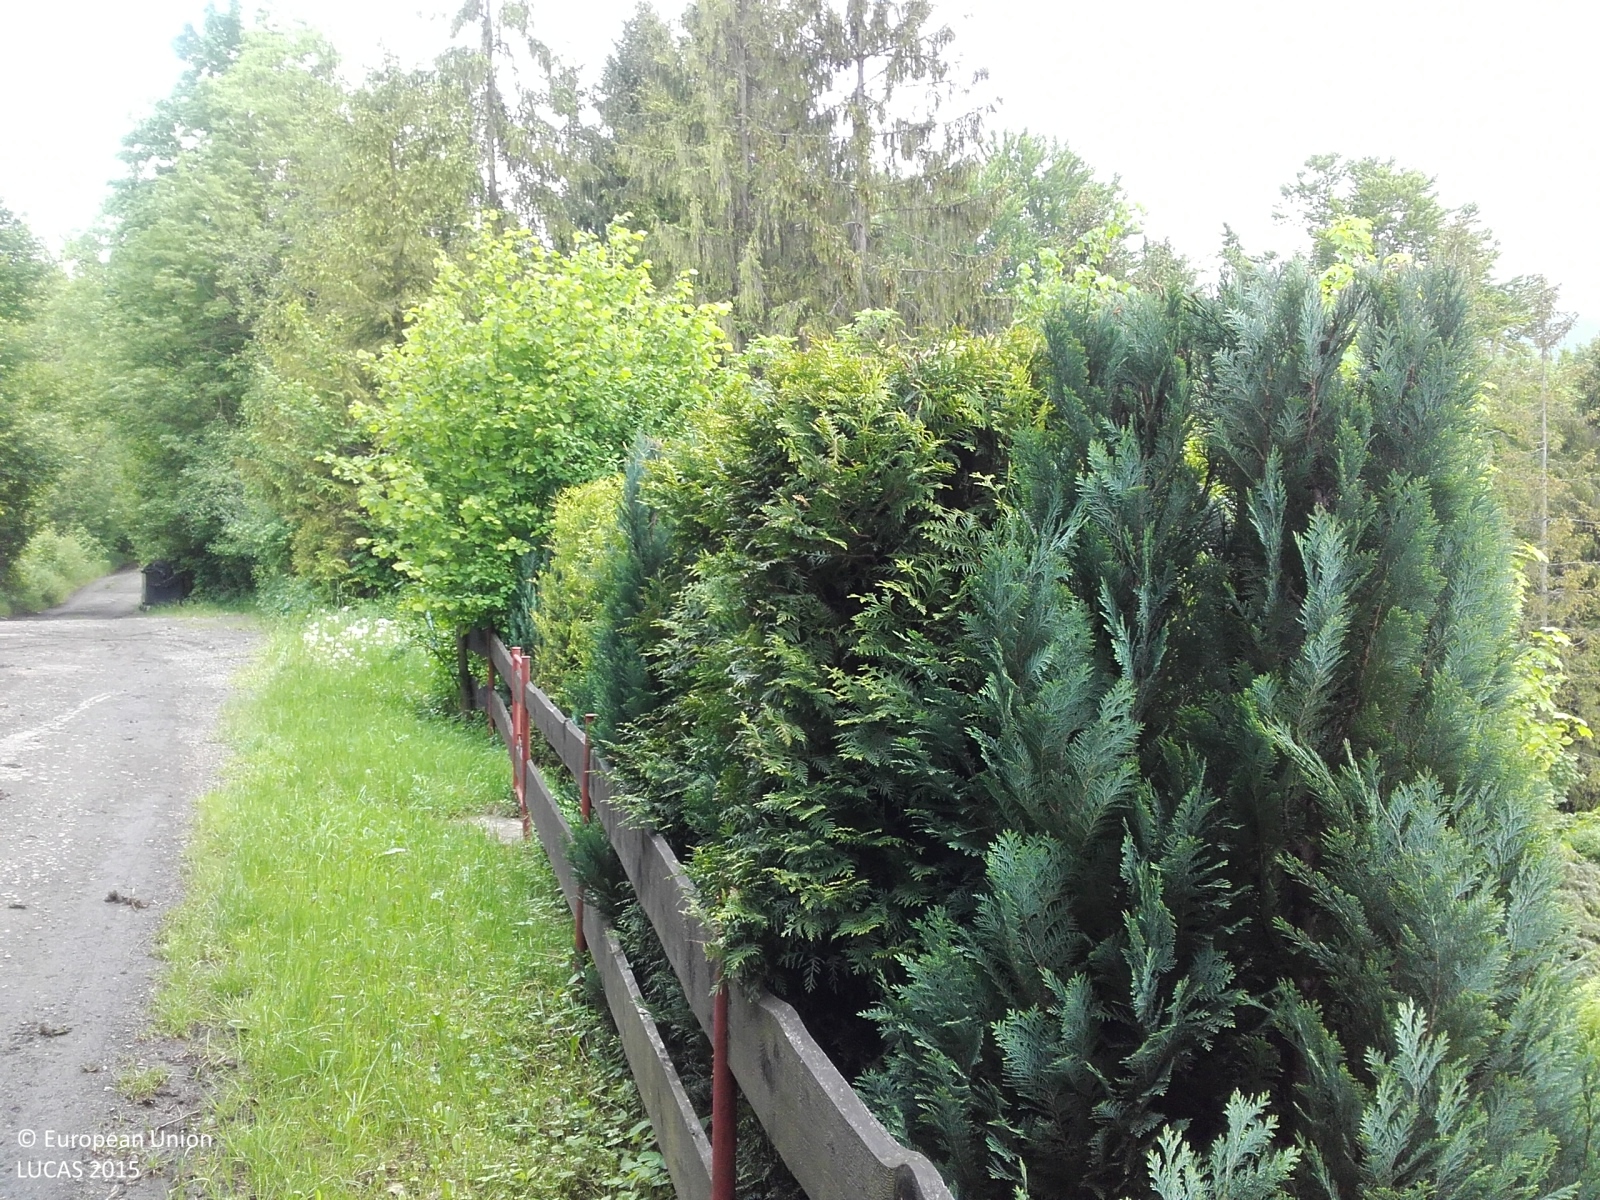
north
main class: Grassland
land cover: Grassland without tree/shrub cover
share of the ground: > 75 %
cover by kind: herbaceous plants 100 %
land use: Residential
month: May
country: CZ
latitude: 49.6654
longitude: 18.7630
